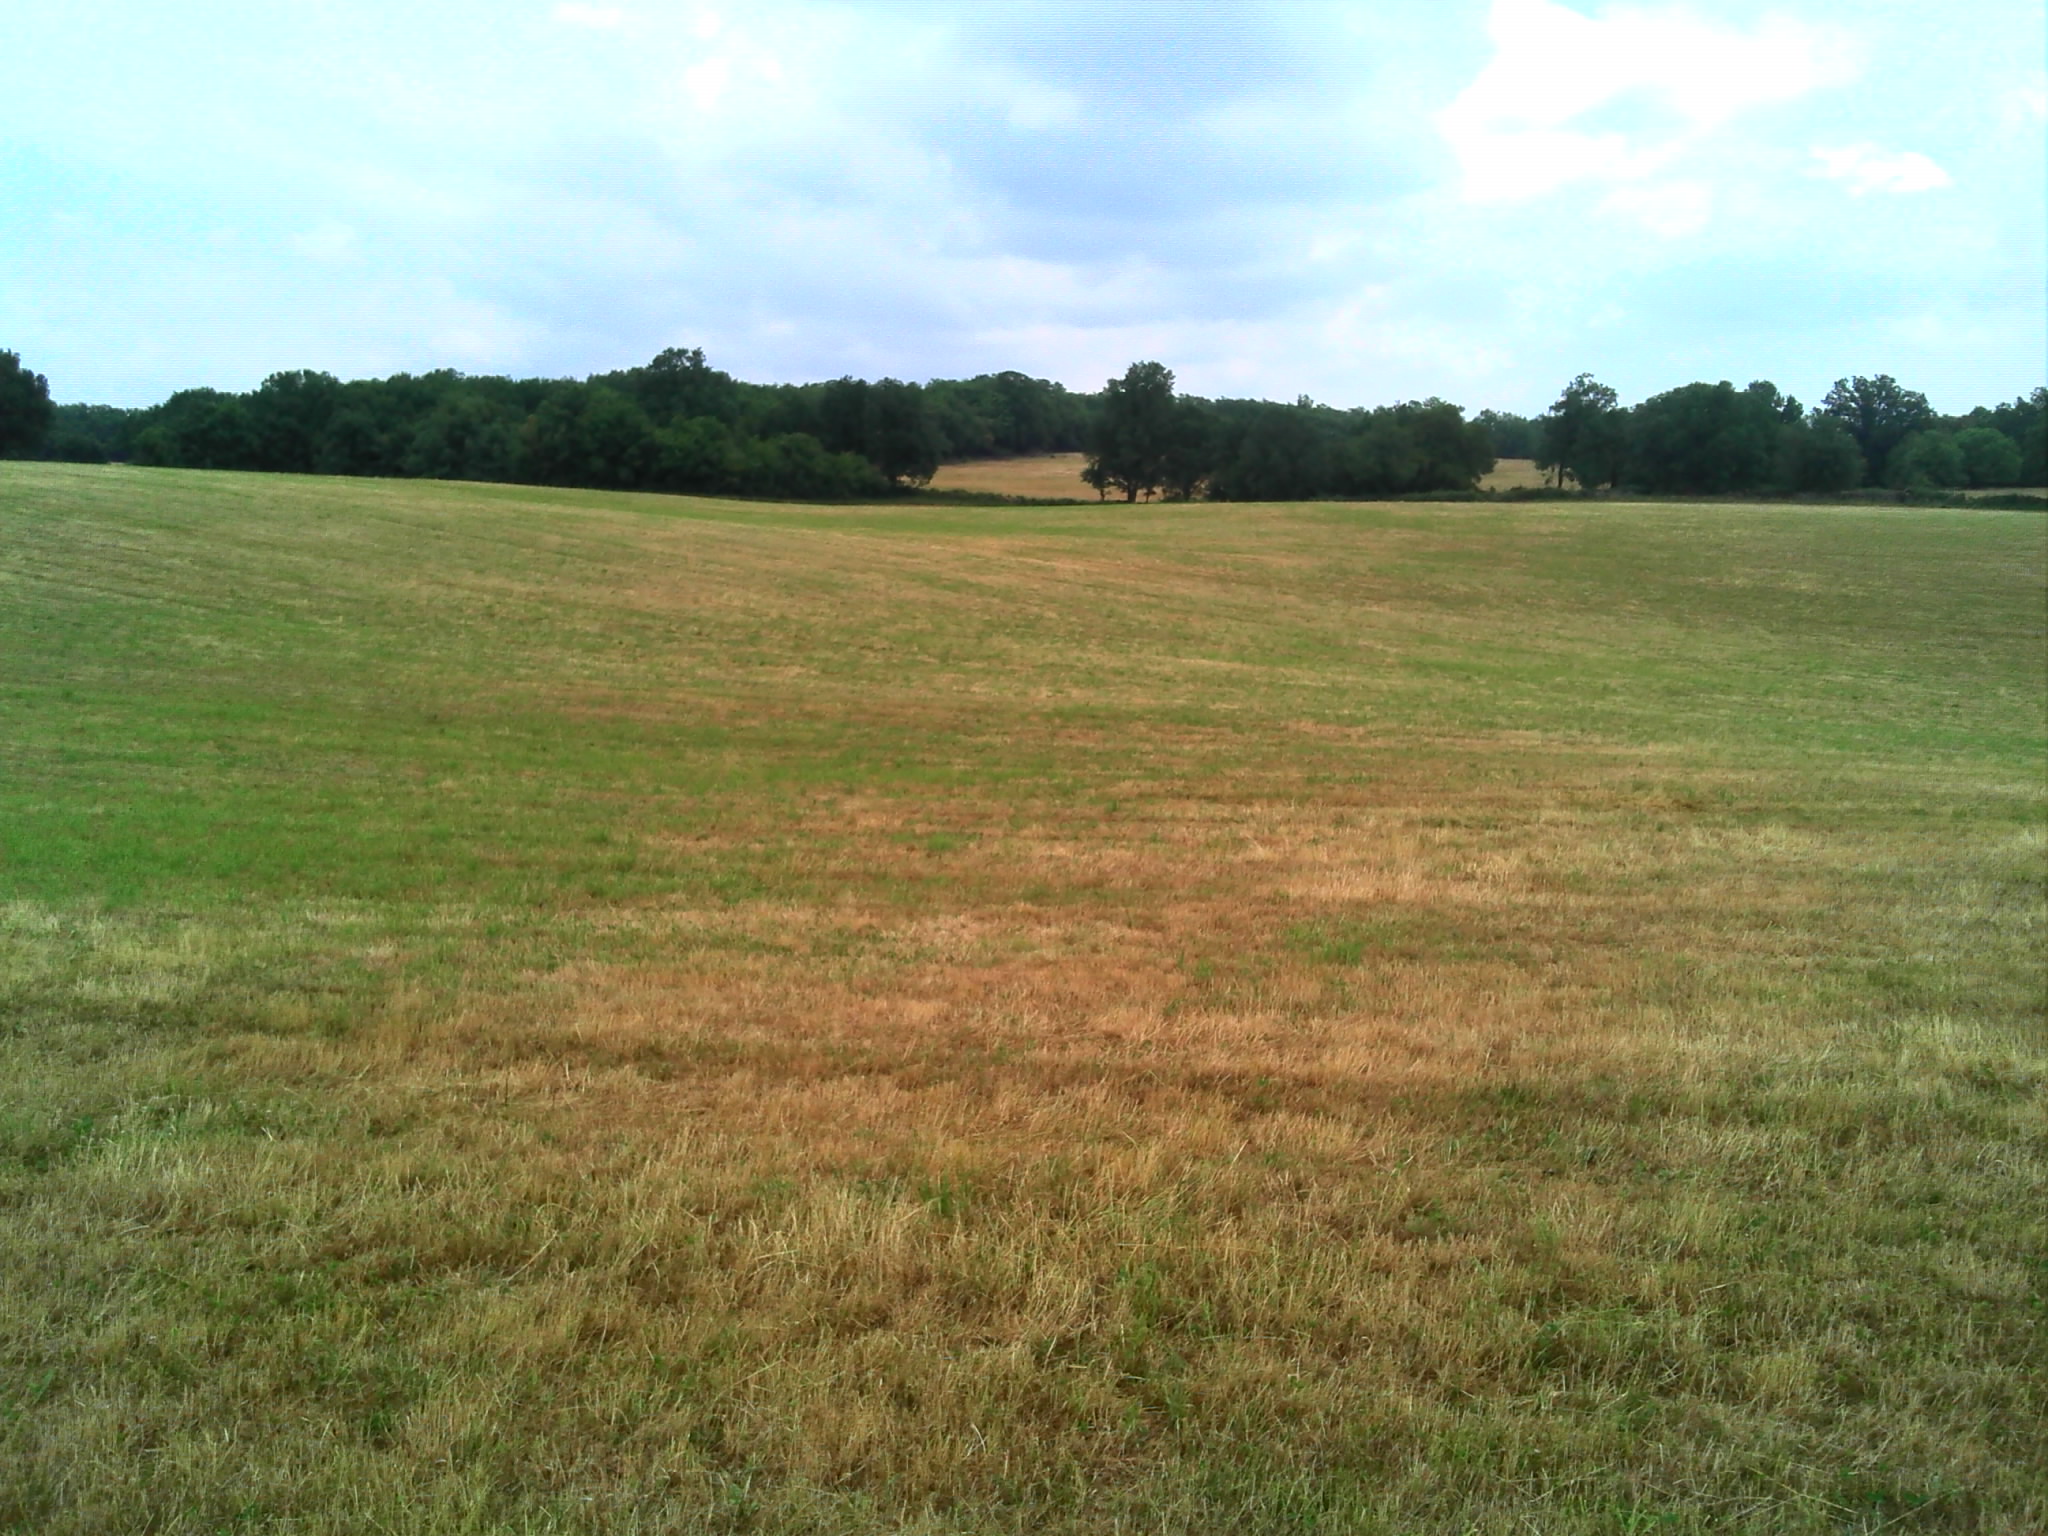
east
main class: Grassland
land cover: Grassland without tree/shrub cover
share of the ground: > 75 %
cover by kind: herbaceous plants 100 %
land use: Agriculture (excluding fallow land and kitchen gardens)
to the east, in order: Grassland without tree/shrub cover
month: June
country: FR
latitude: 44.6967
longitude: 1.8088
